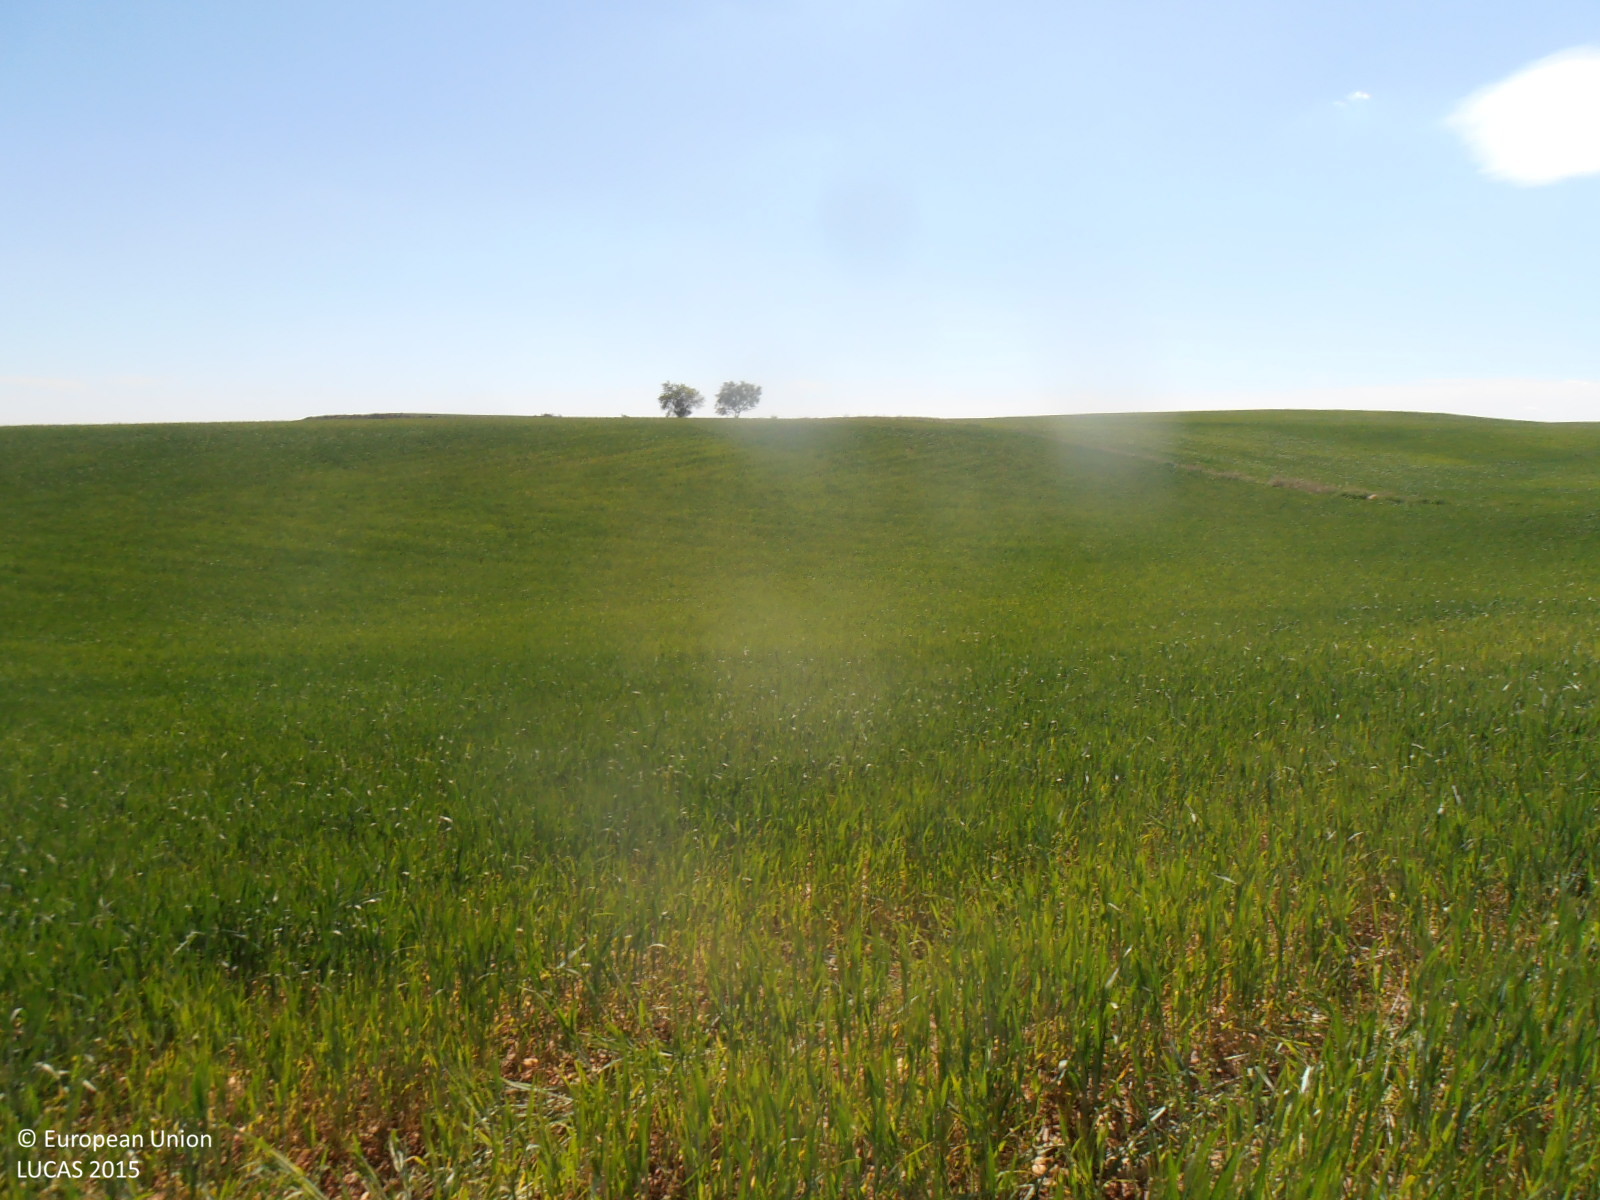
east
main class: Cropland
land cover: Durum wheat
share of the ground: > 75 %
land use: Agriculture (excluding fallow land and kitchen gardens)
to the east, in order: Durum wheat; Grass margins; Tracks; Grass margins; Dry stone walls
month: April
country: ES
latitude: 41.3086
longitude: -1.1408
